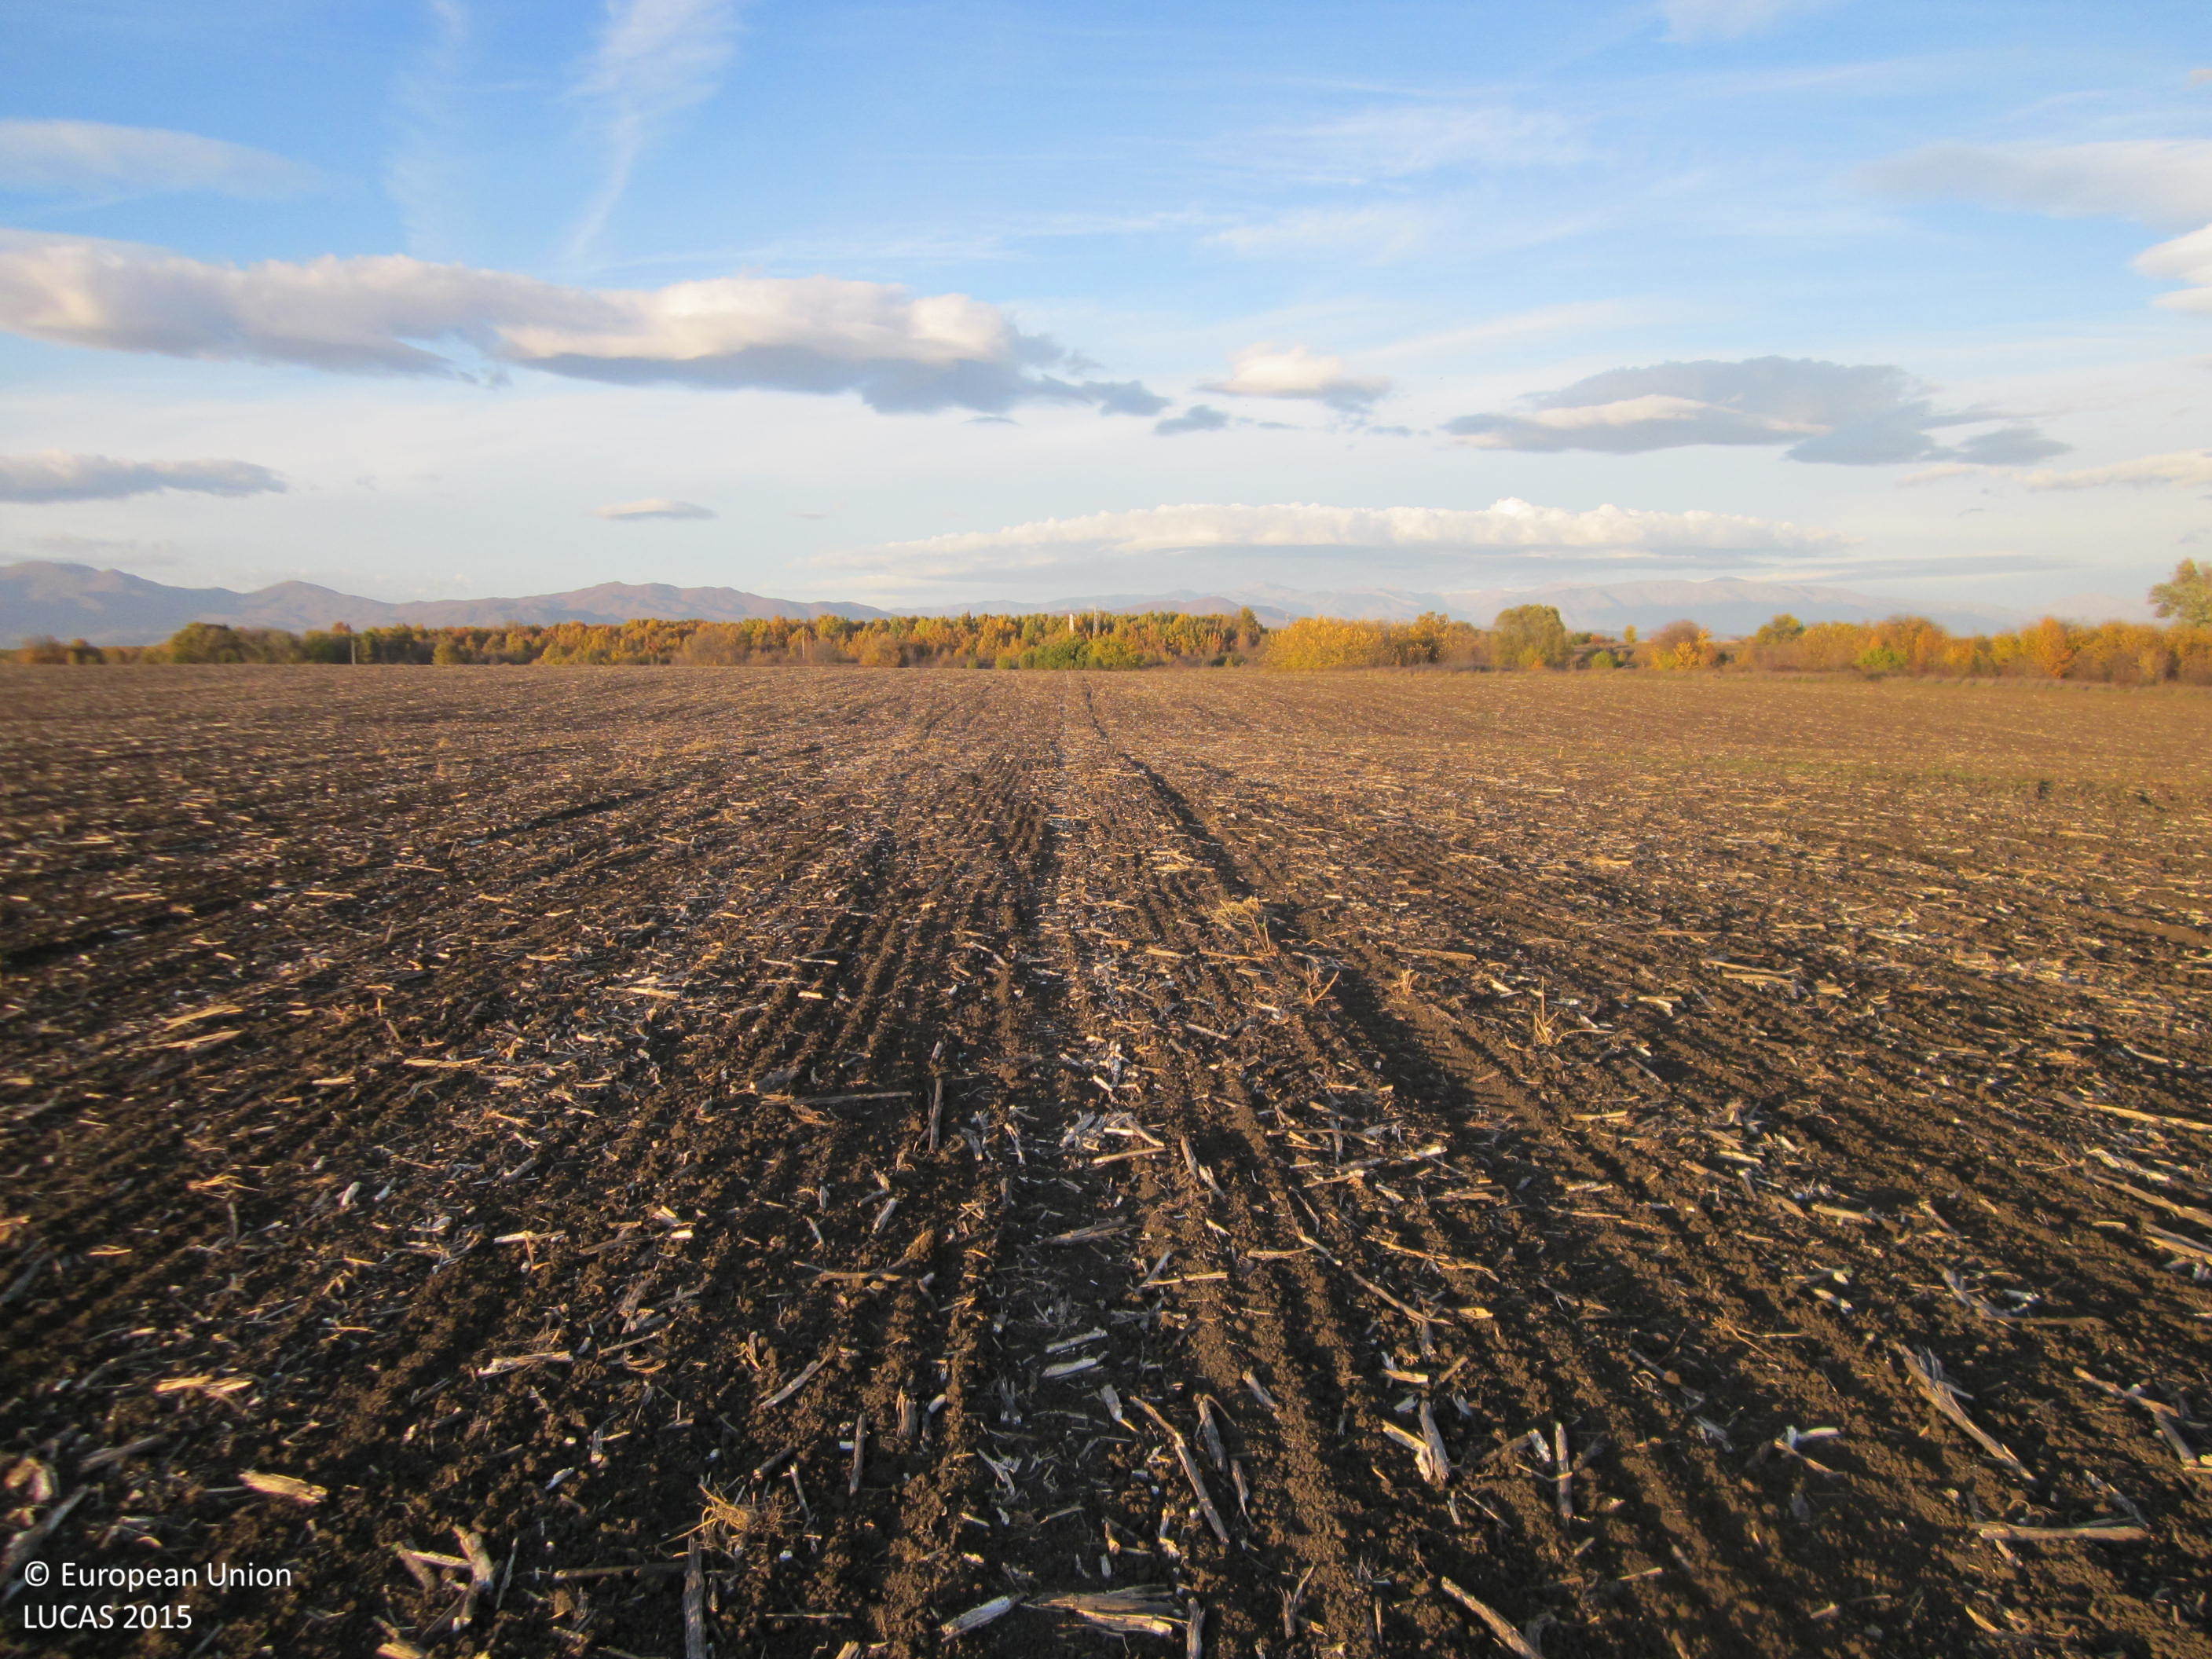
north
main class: Cropland
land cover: Sunflower
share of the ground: < 10 %
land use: Agriculture (excluding fallow land and kitchen gardens)
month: November
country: BG
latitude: 42.3932
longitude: 24.6172
